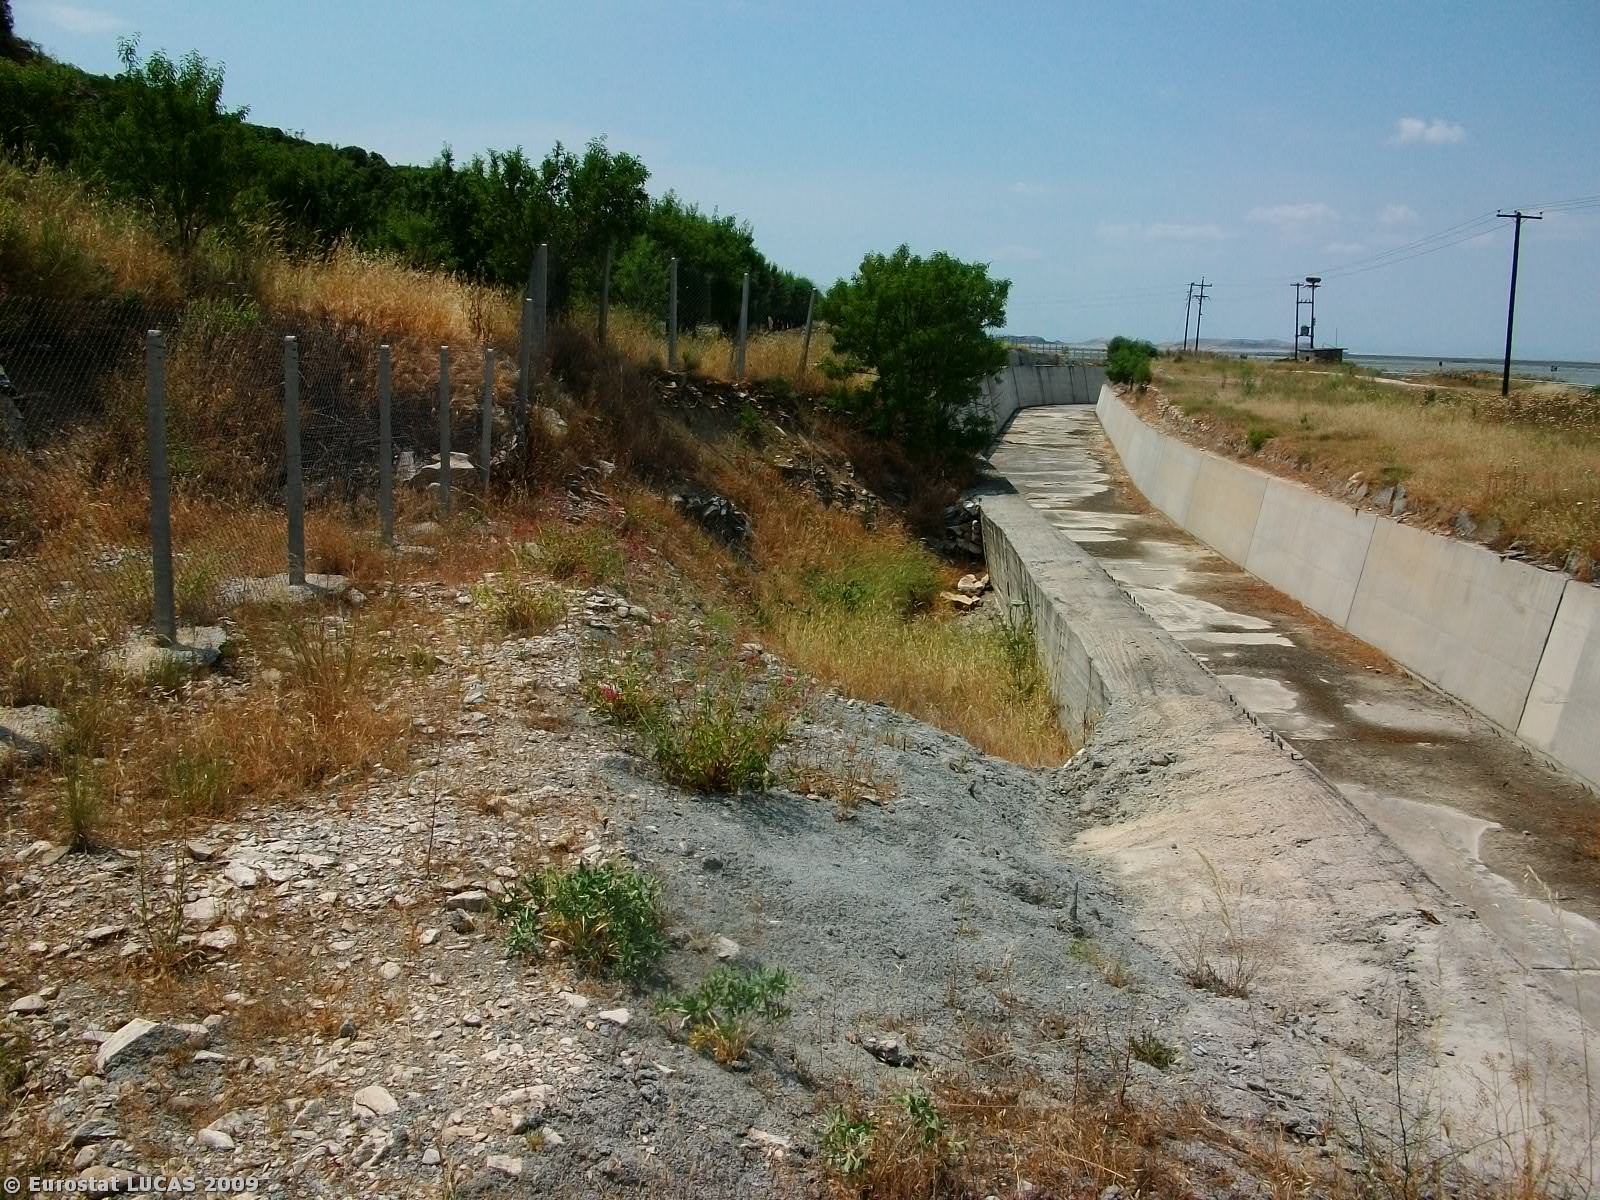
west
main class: Cropland
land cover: Nuts trees
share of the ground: 25 - 50 %
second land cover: Shrubland with sparse tree cover
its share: 50 - 75 %
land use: Agriculture (excluding fallow land and kitchen gardens)
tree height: < 5 m
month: May
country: GR
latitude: 39.4720
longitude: 22.8601
